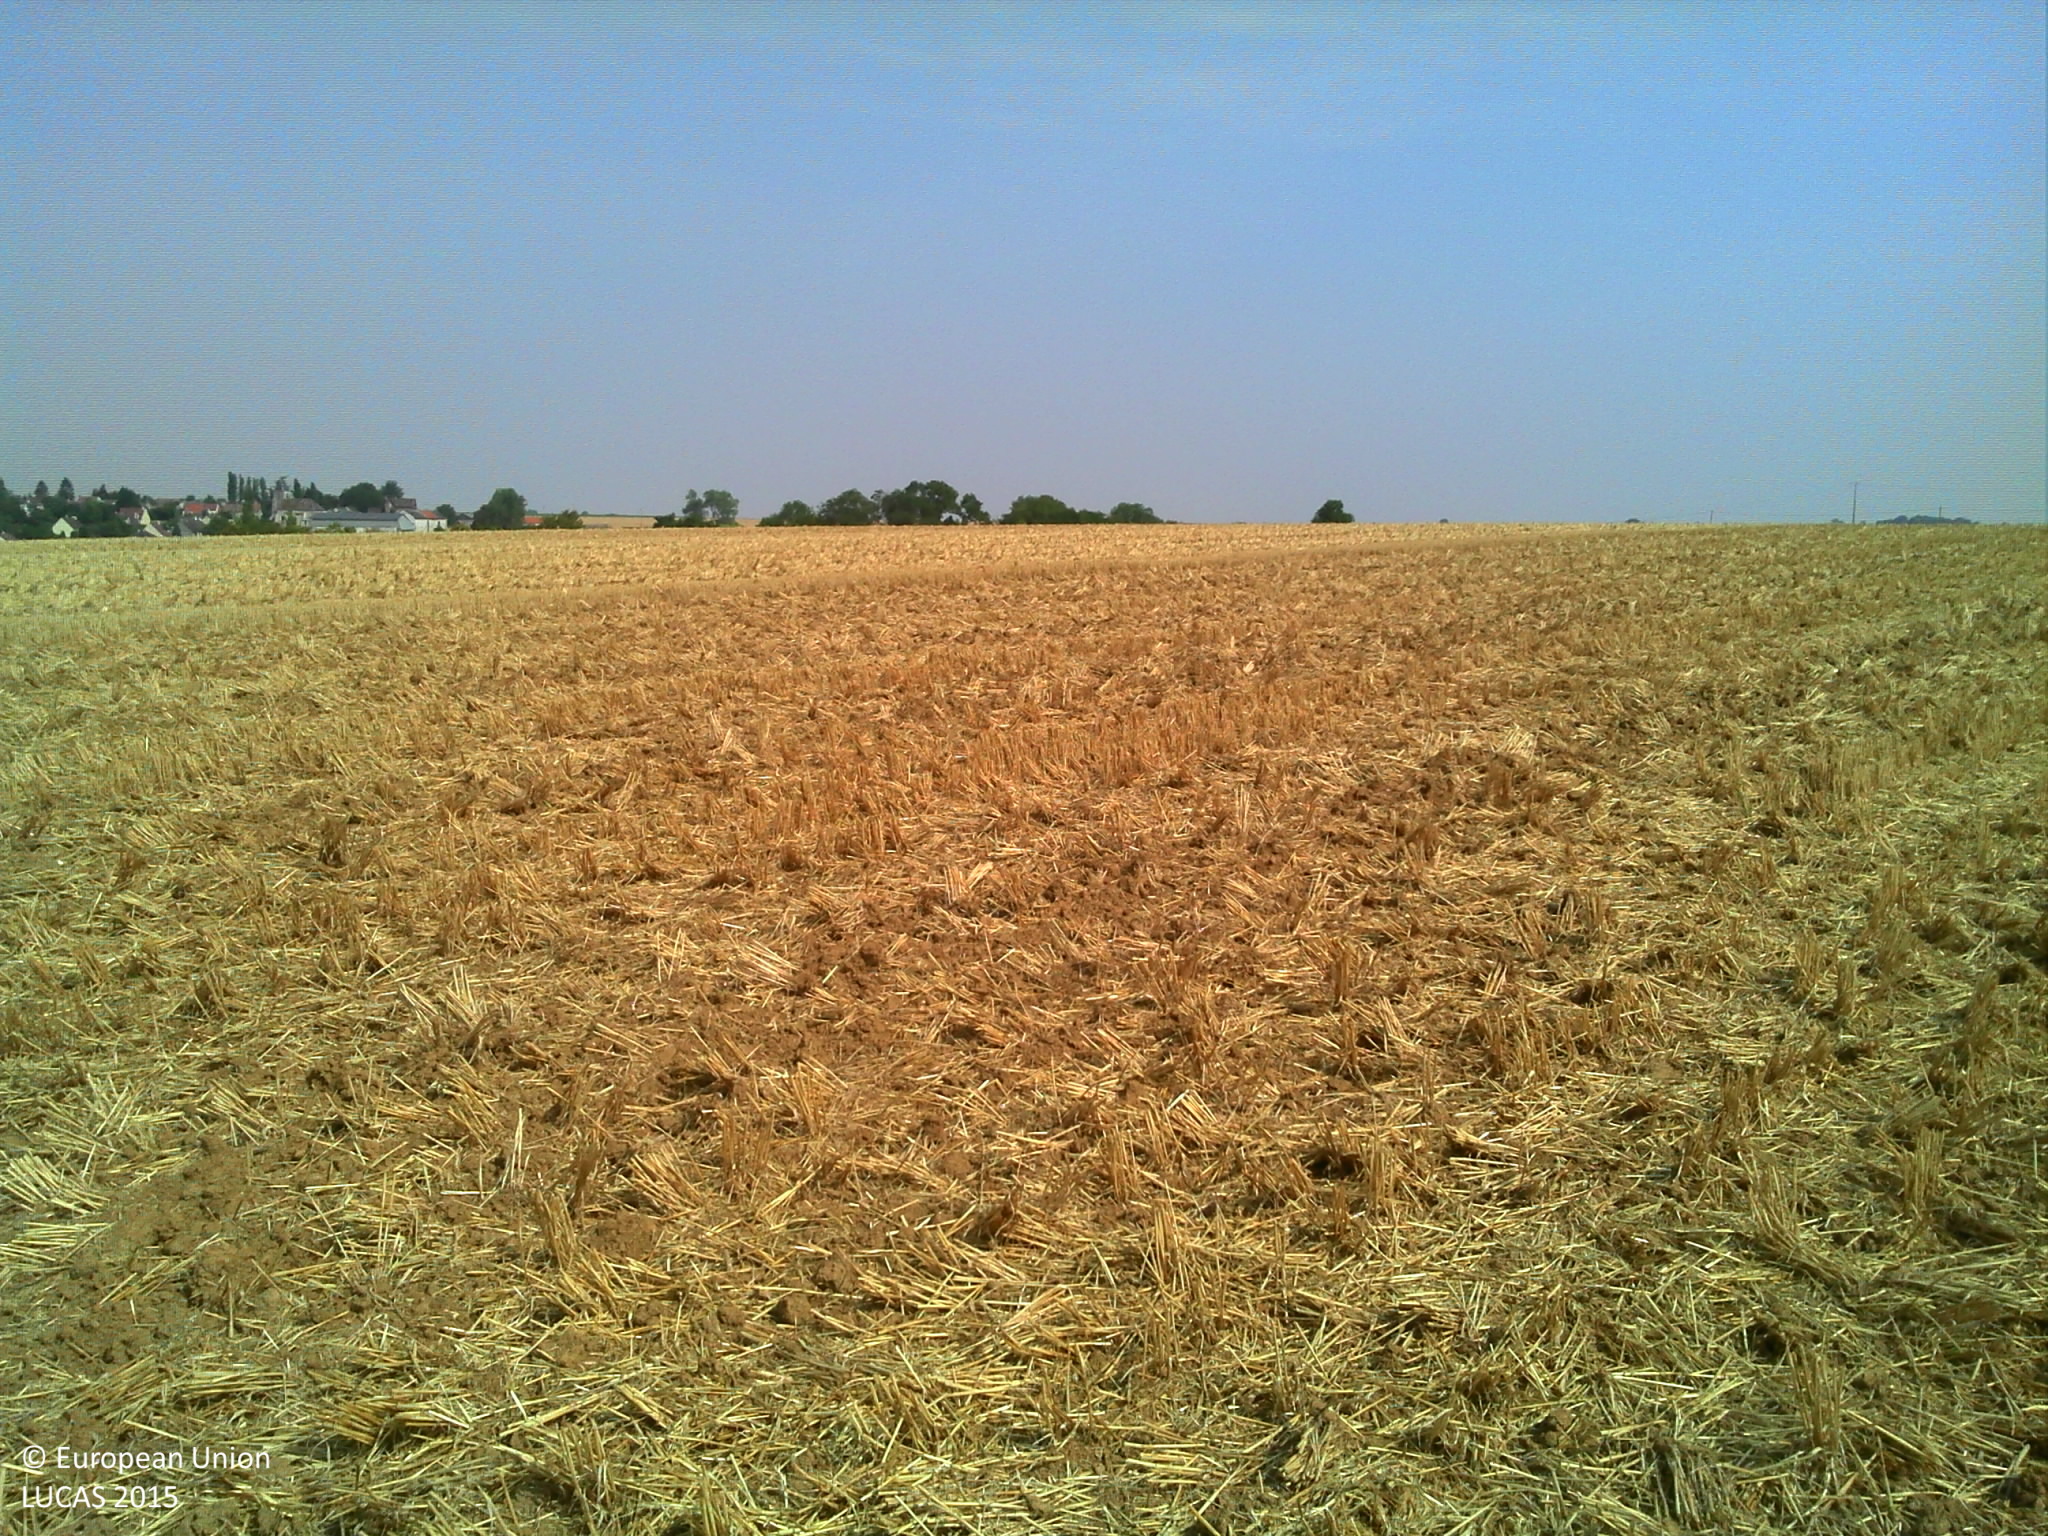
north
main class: Cropland
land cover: Common wheat
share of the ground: > 75 %
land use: Agriculture (excluding fallow land and kitchen gardens)
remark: Harvested field
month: August
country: FR
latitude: 49.0593
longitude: 2.8879
